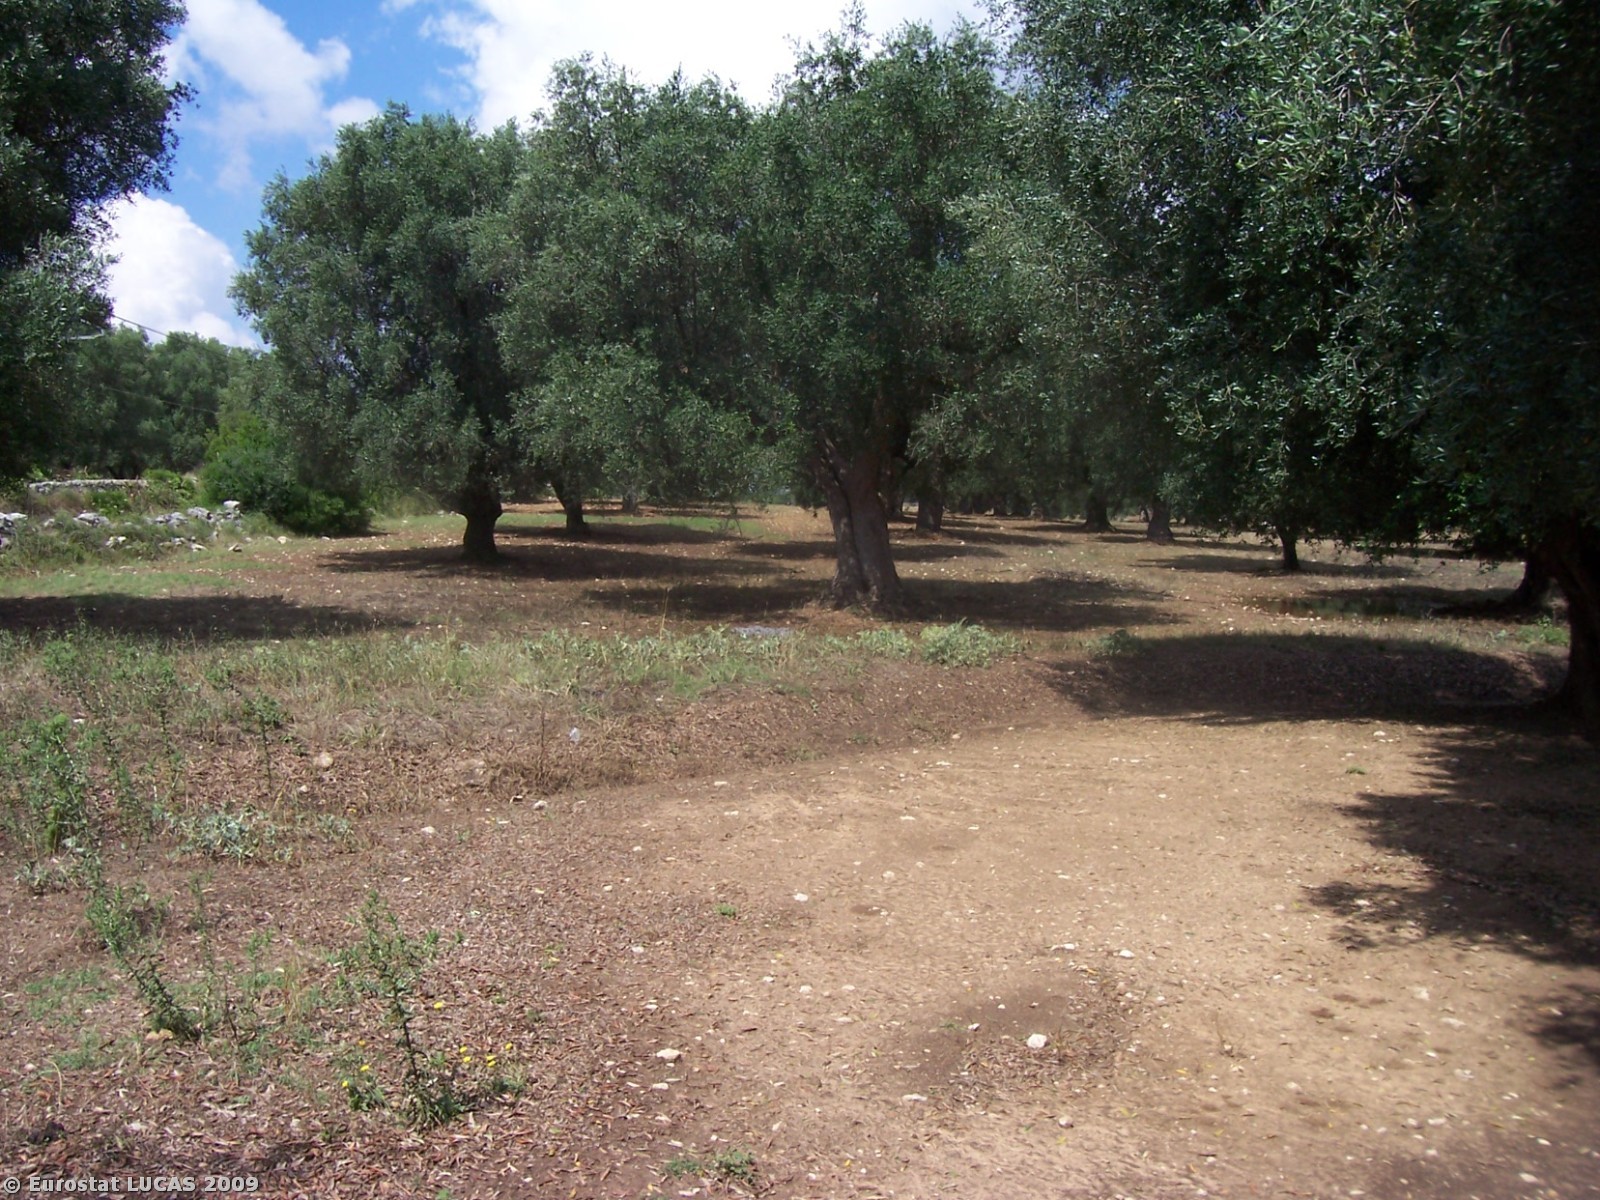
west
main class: Cropland
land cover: Olive groves
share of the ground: 50 - 75 %
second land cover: Bare land
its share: > 75 %
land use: Agriculture (excluding fallow land and kitchen gardens)
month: July
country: IT
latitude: 40.5234
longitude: 17.5186
